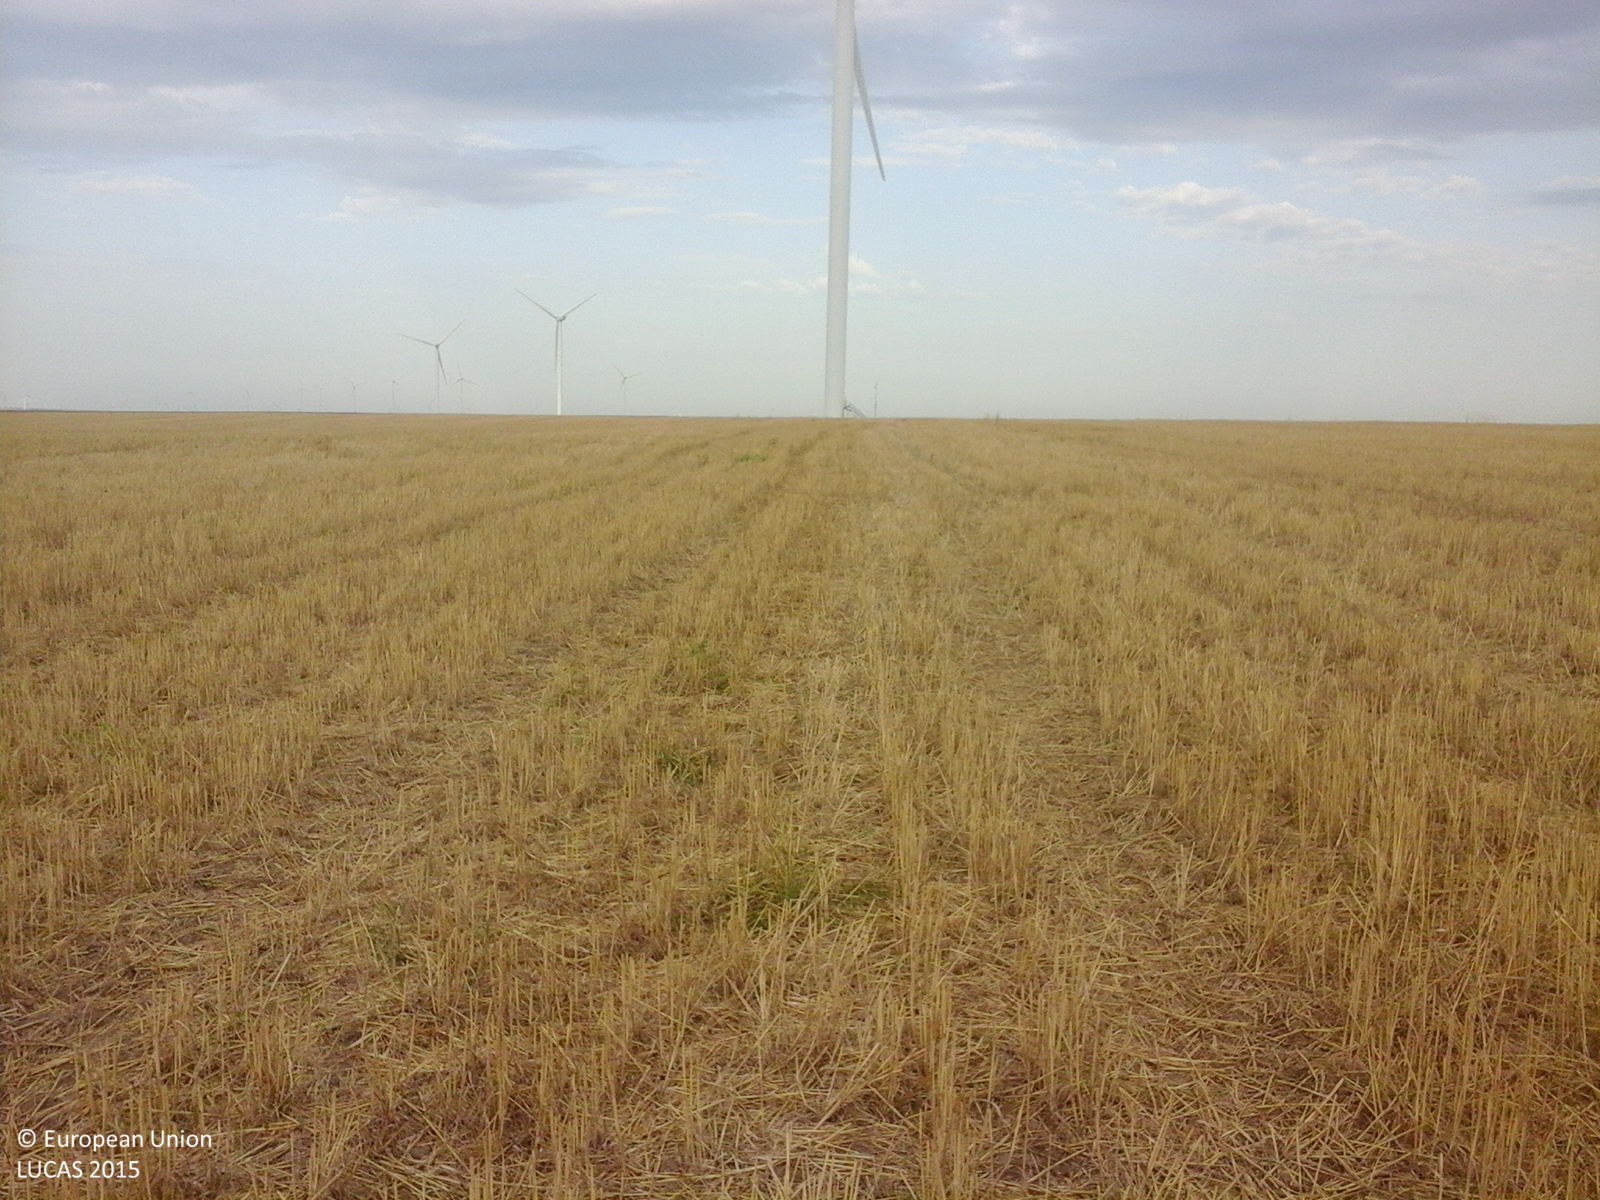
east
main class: Cropland
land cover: Common wheat
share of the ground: > 75 %
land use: Agriculture (excluding fallow land and kitchen gardens)
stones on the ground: < 10 %
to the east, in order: Common wheat
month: August
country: RO
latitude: 44.3894
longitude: 28.1760
